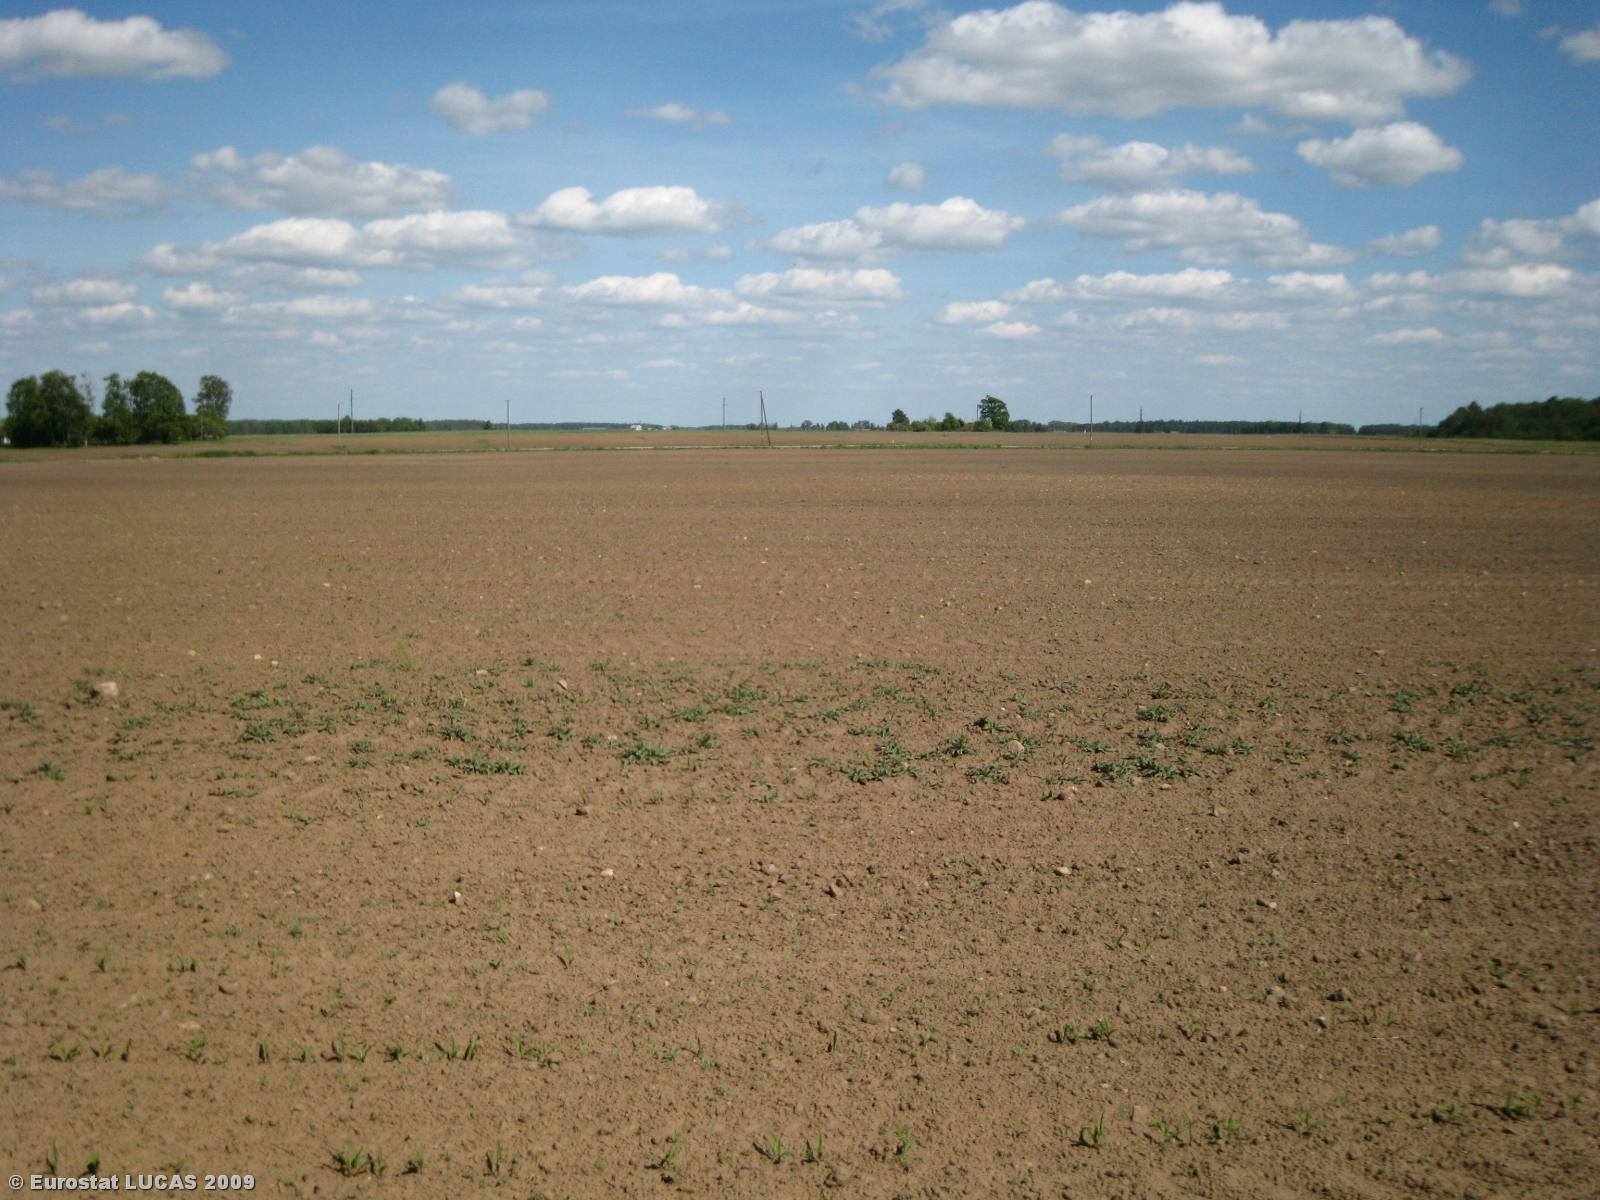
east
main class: Cropland
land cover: Maize
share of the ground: 50 - 75 %
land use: Agriculture (excluding fallow land and kitchen gardens)
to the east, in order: Maize; Grass margins; Paved roads, cycling and walking lanes; Grass margins; Maize
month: May
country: LT
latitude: 55.7798
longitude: 24.0075
